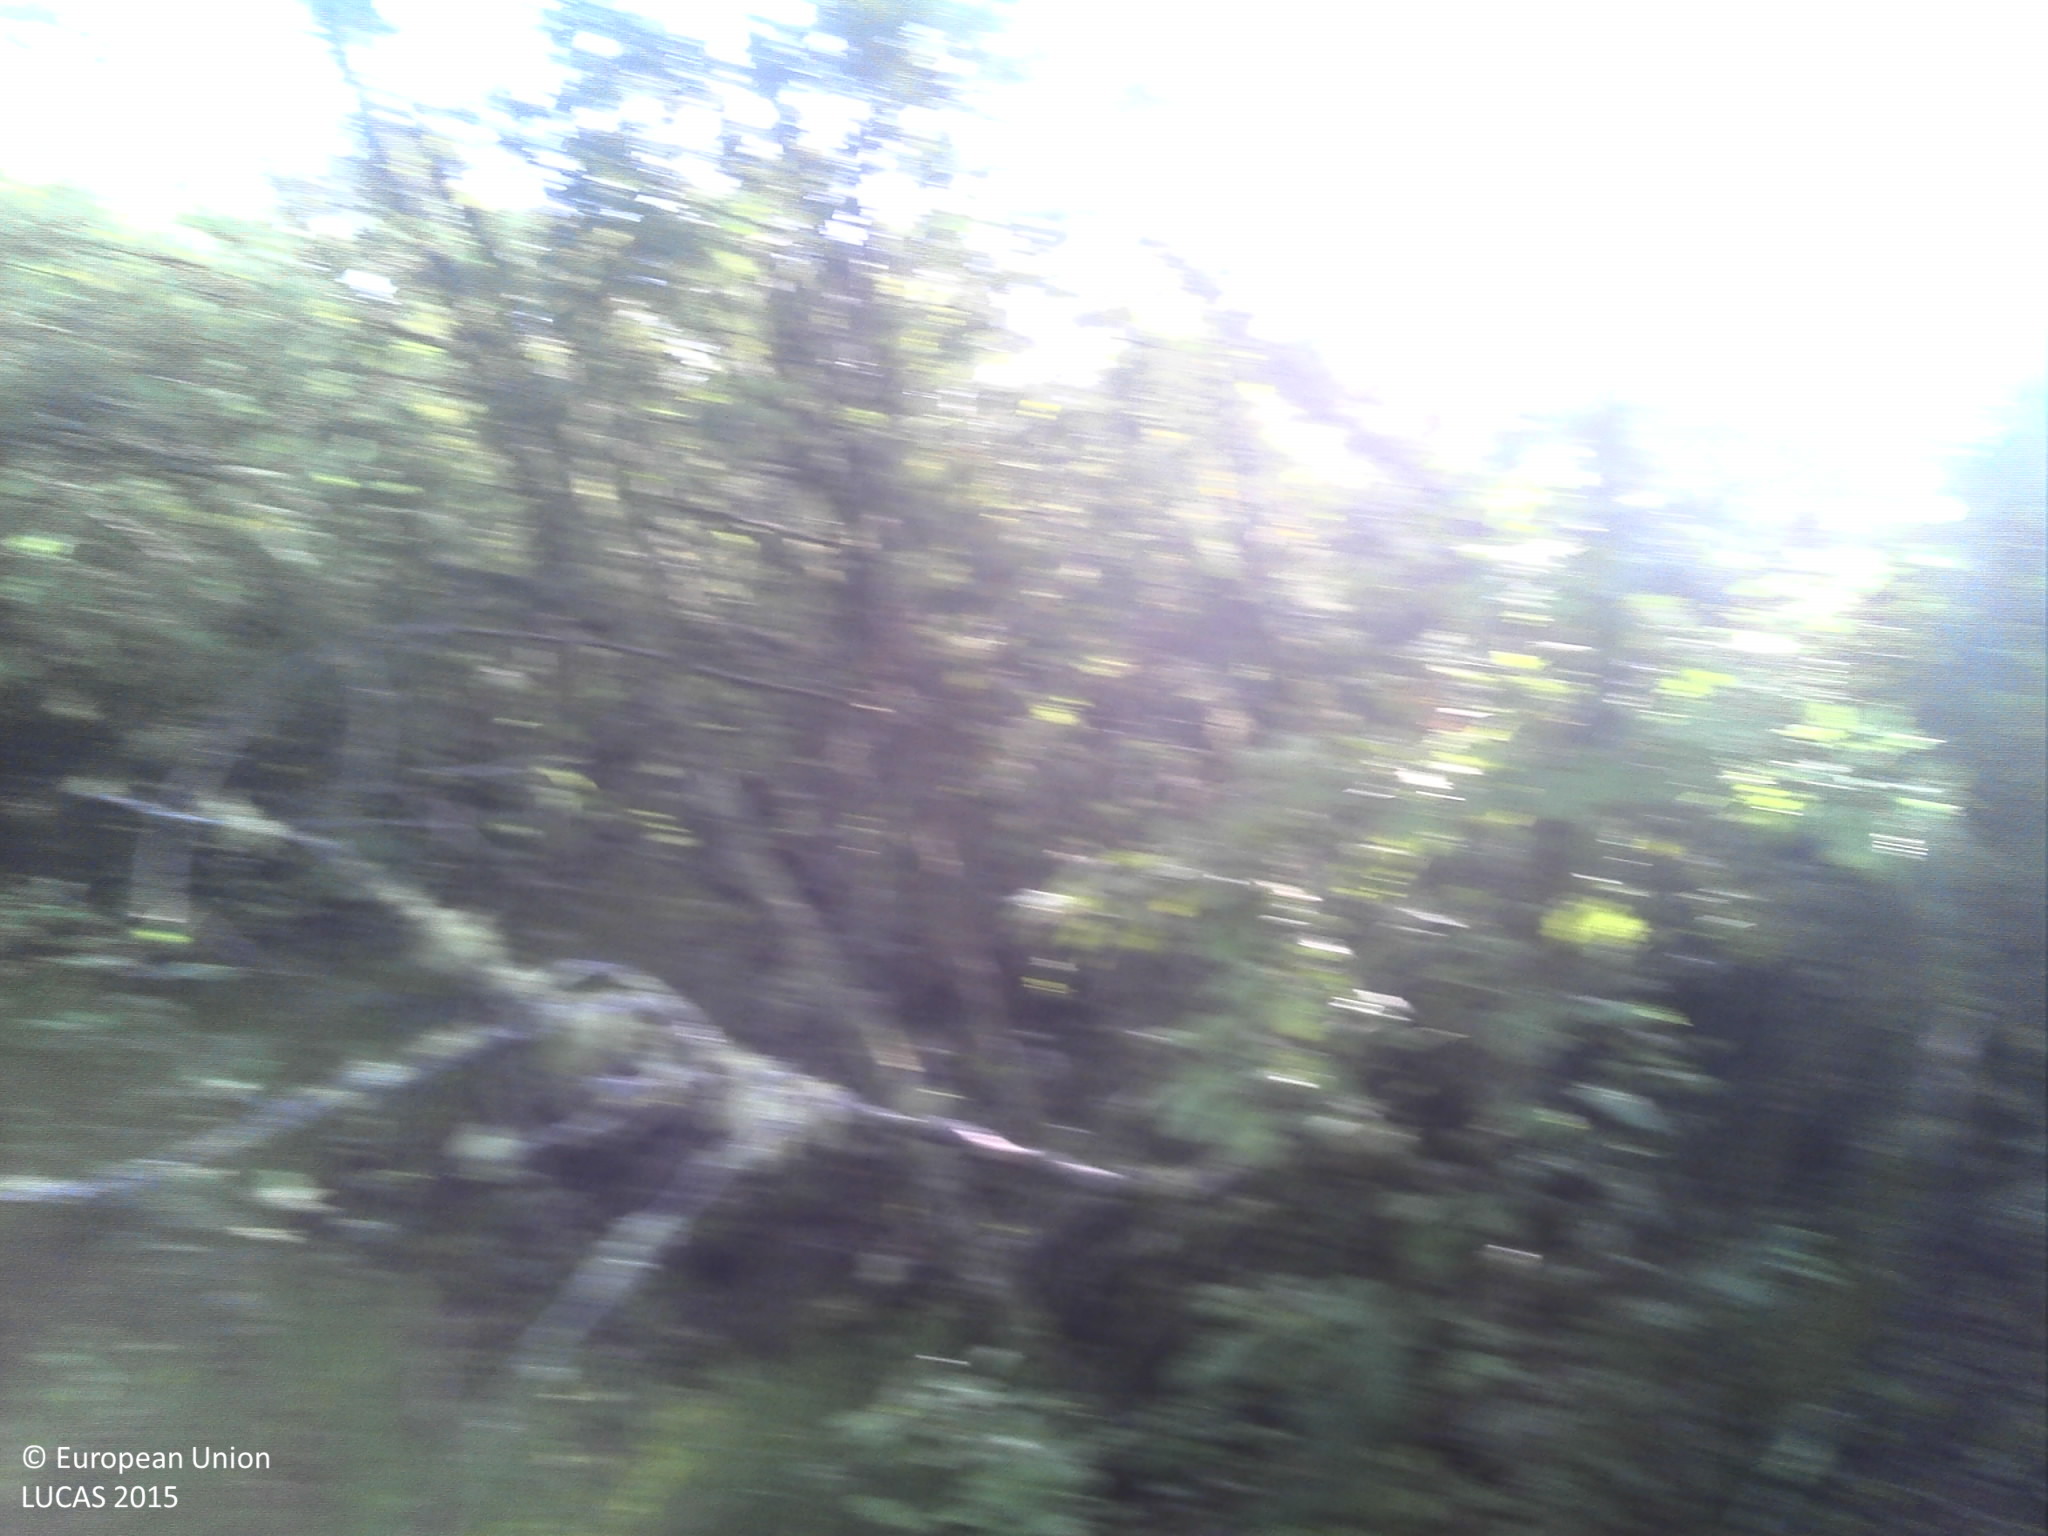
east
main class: Woodland
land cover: Broadleaved woodland
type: acidophilous oak and oak-birch forest
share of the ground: 25 - 50 %
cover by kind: broadleaved forest trees 50 %, shrubs 25 %, herbaceous plants 15 %, unconsolidated bare surface 10 %
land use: Forestry
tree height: > 5 m
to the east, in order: Broadleaved woodland; Shrubland without tree cover; Pine dominated coniferous woodland; Arable land (only in case pi); Broadleaved woodland; Arable land (only in case pi); Pine dominated coniferous woodland; Shrubland without tree cover; Pine dominated coniferous woodland; Broadleaved woodland; Permanent crops (only in case pi)
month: May
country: PT
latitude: 40.6599
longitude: -7.7800
